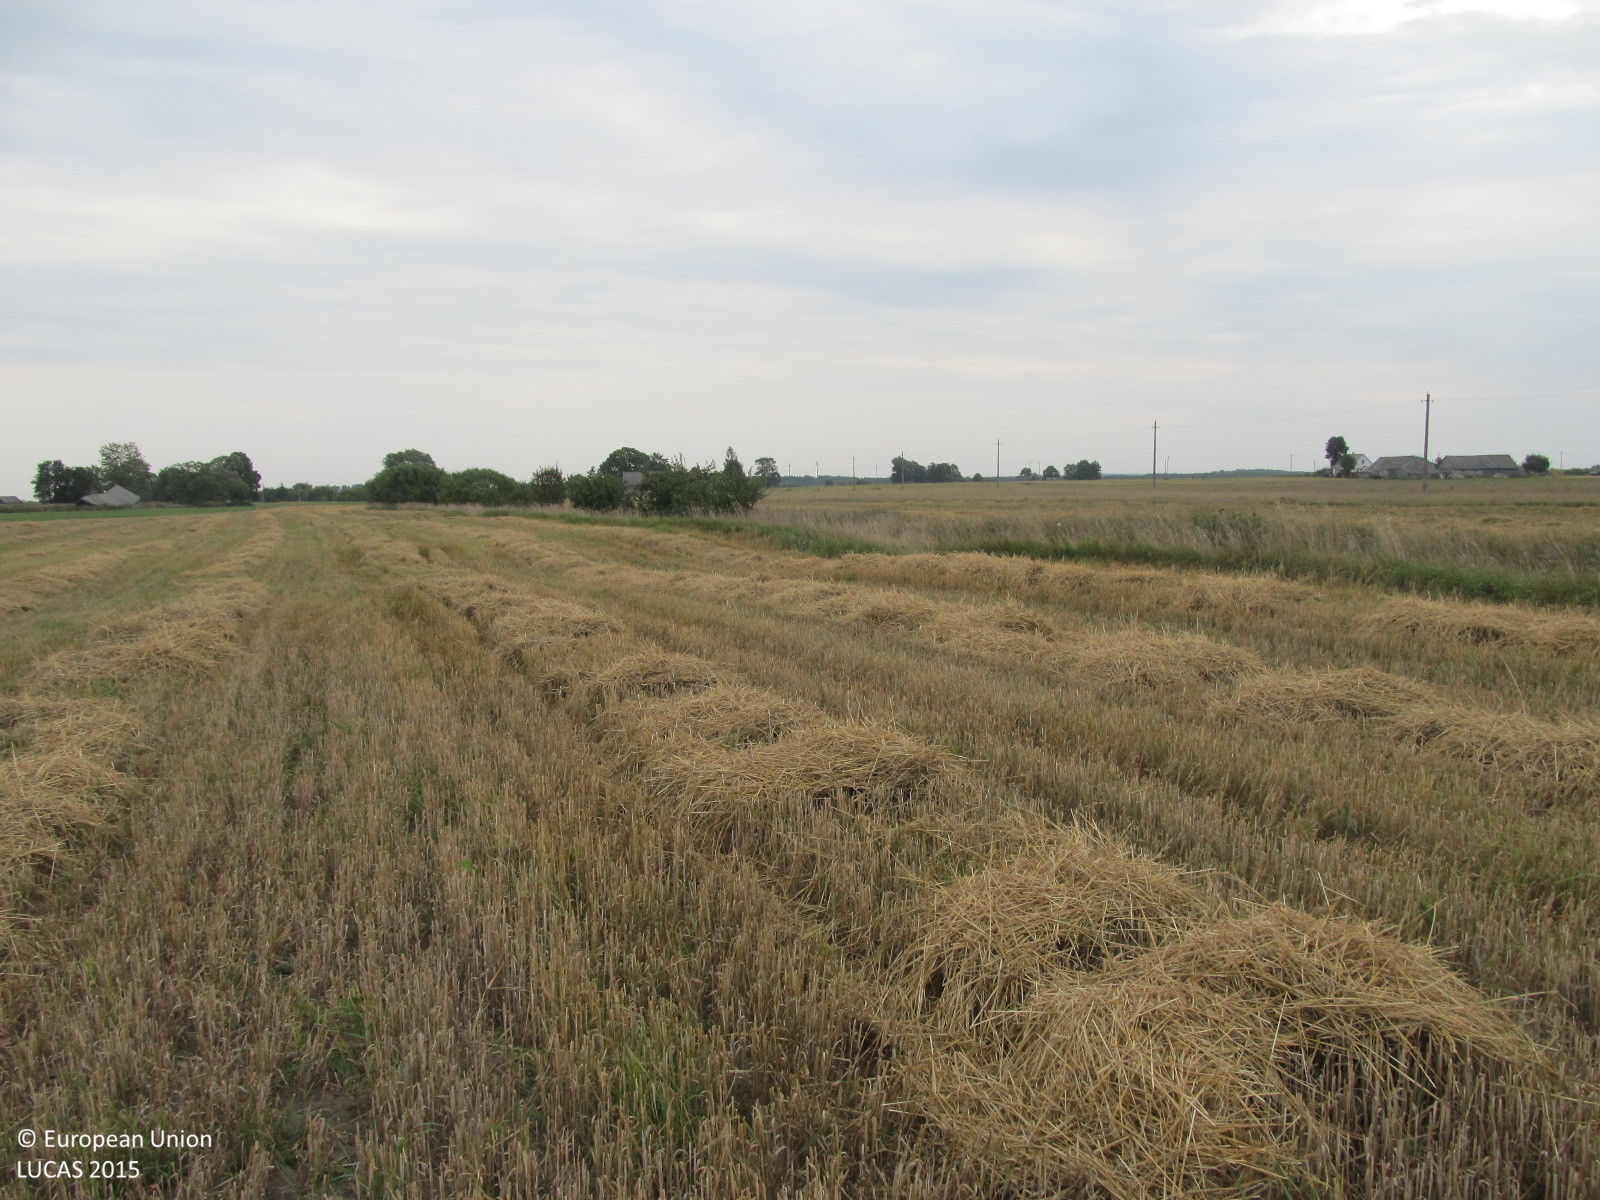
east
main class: Cropland
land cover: Common wheat
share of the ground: > 75 %
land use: Agriculture (excluding fallow land and kitchen gardens)
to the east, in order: Common wheat; Spontaneously vegetated surfaces; Ditches and canals; Abandoned hedges; Spontaneously vegetated surfaces; Common wheat; Grassland without tree/shrub cover
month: August
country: LT
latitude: 55.6275
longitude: 23.0457
